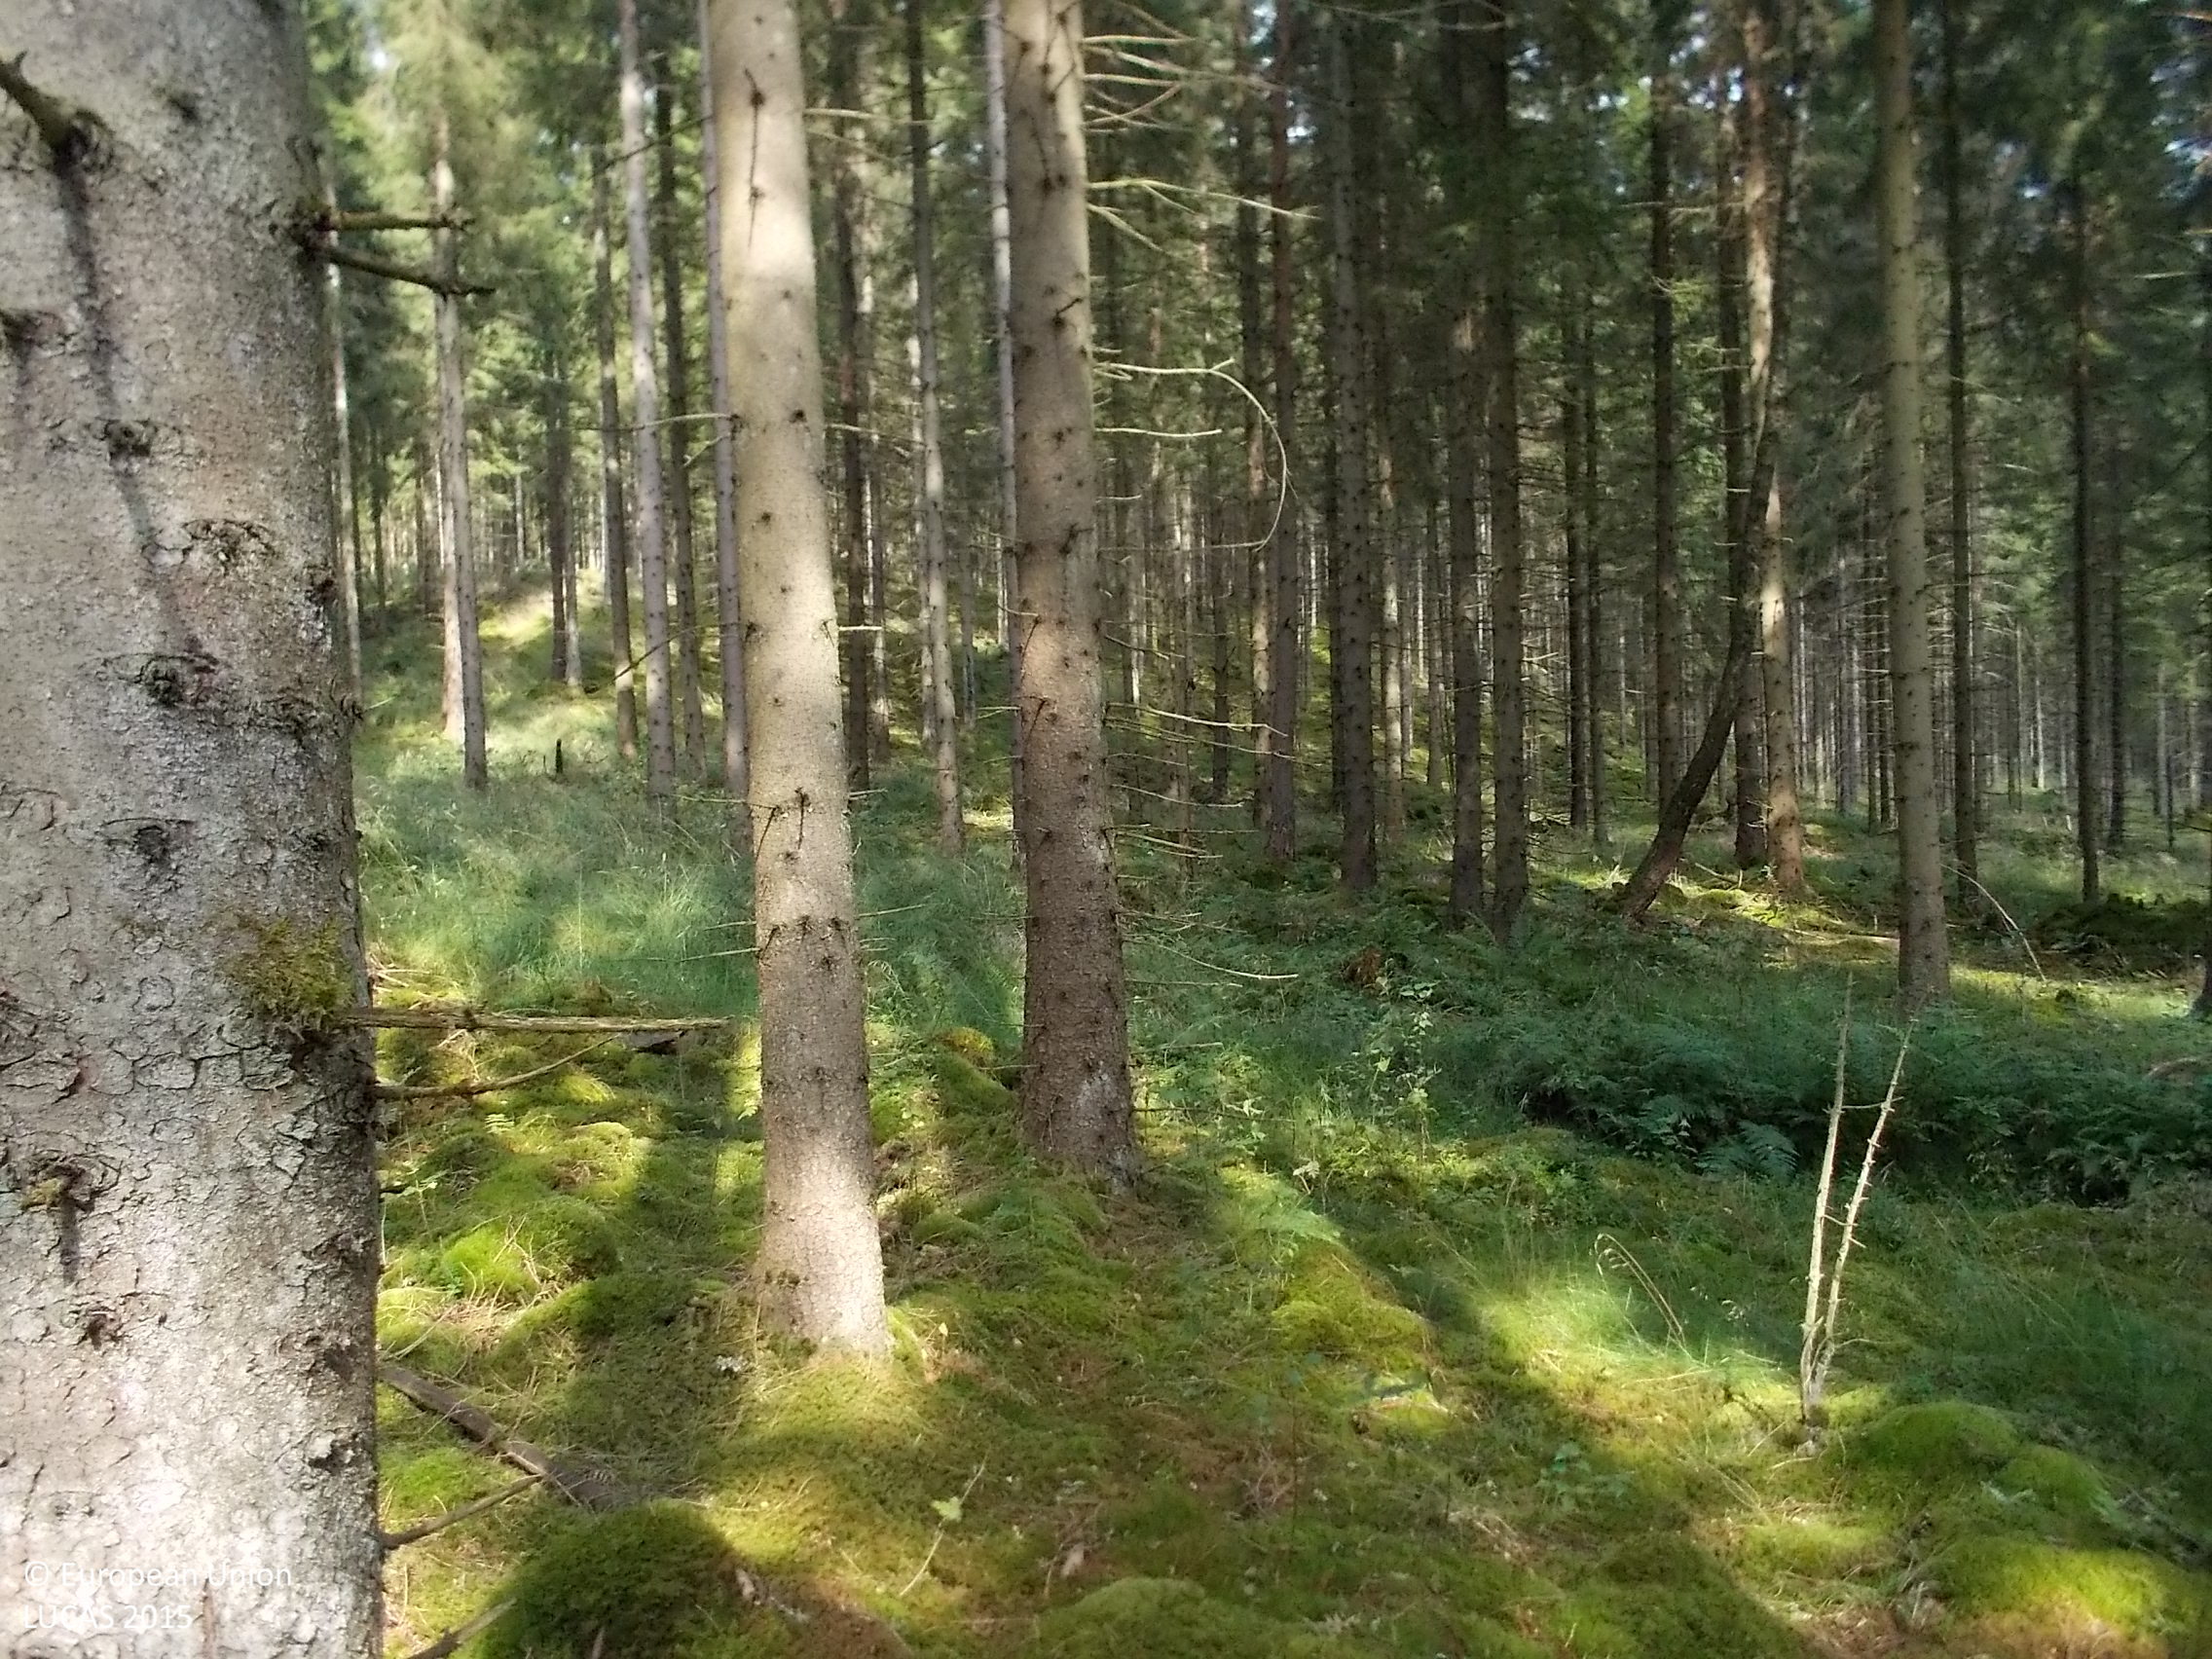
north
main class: Woodland
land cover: Spruce dominated coniferous woodland
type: boreal forest
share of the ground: > 75 %
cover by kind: coniferous forest trees 85 %, herbaceous plants 10 %, lichens and mosses 5 %
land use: Forestry
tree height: > 5 m
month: August
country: SE
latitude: 57.3222
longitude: 13.0018
